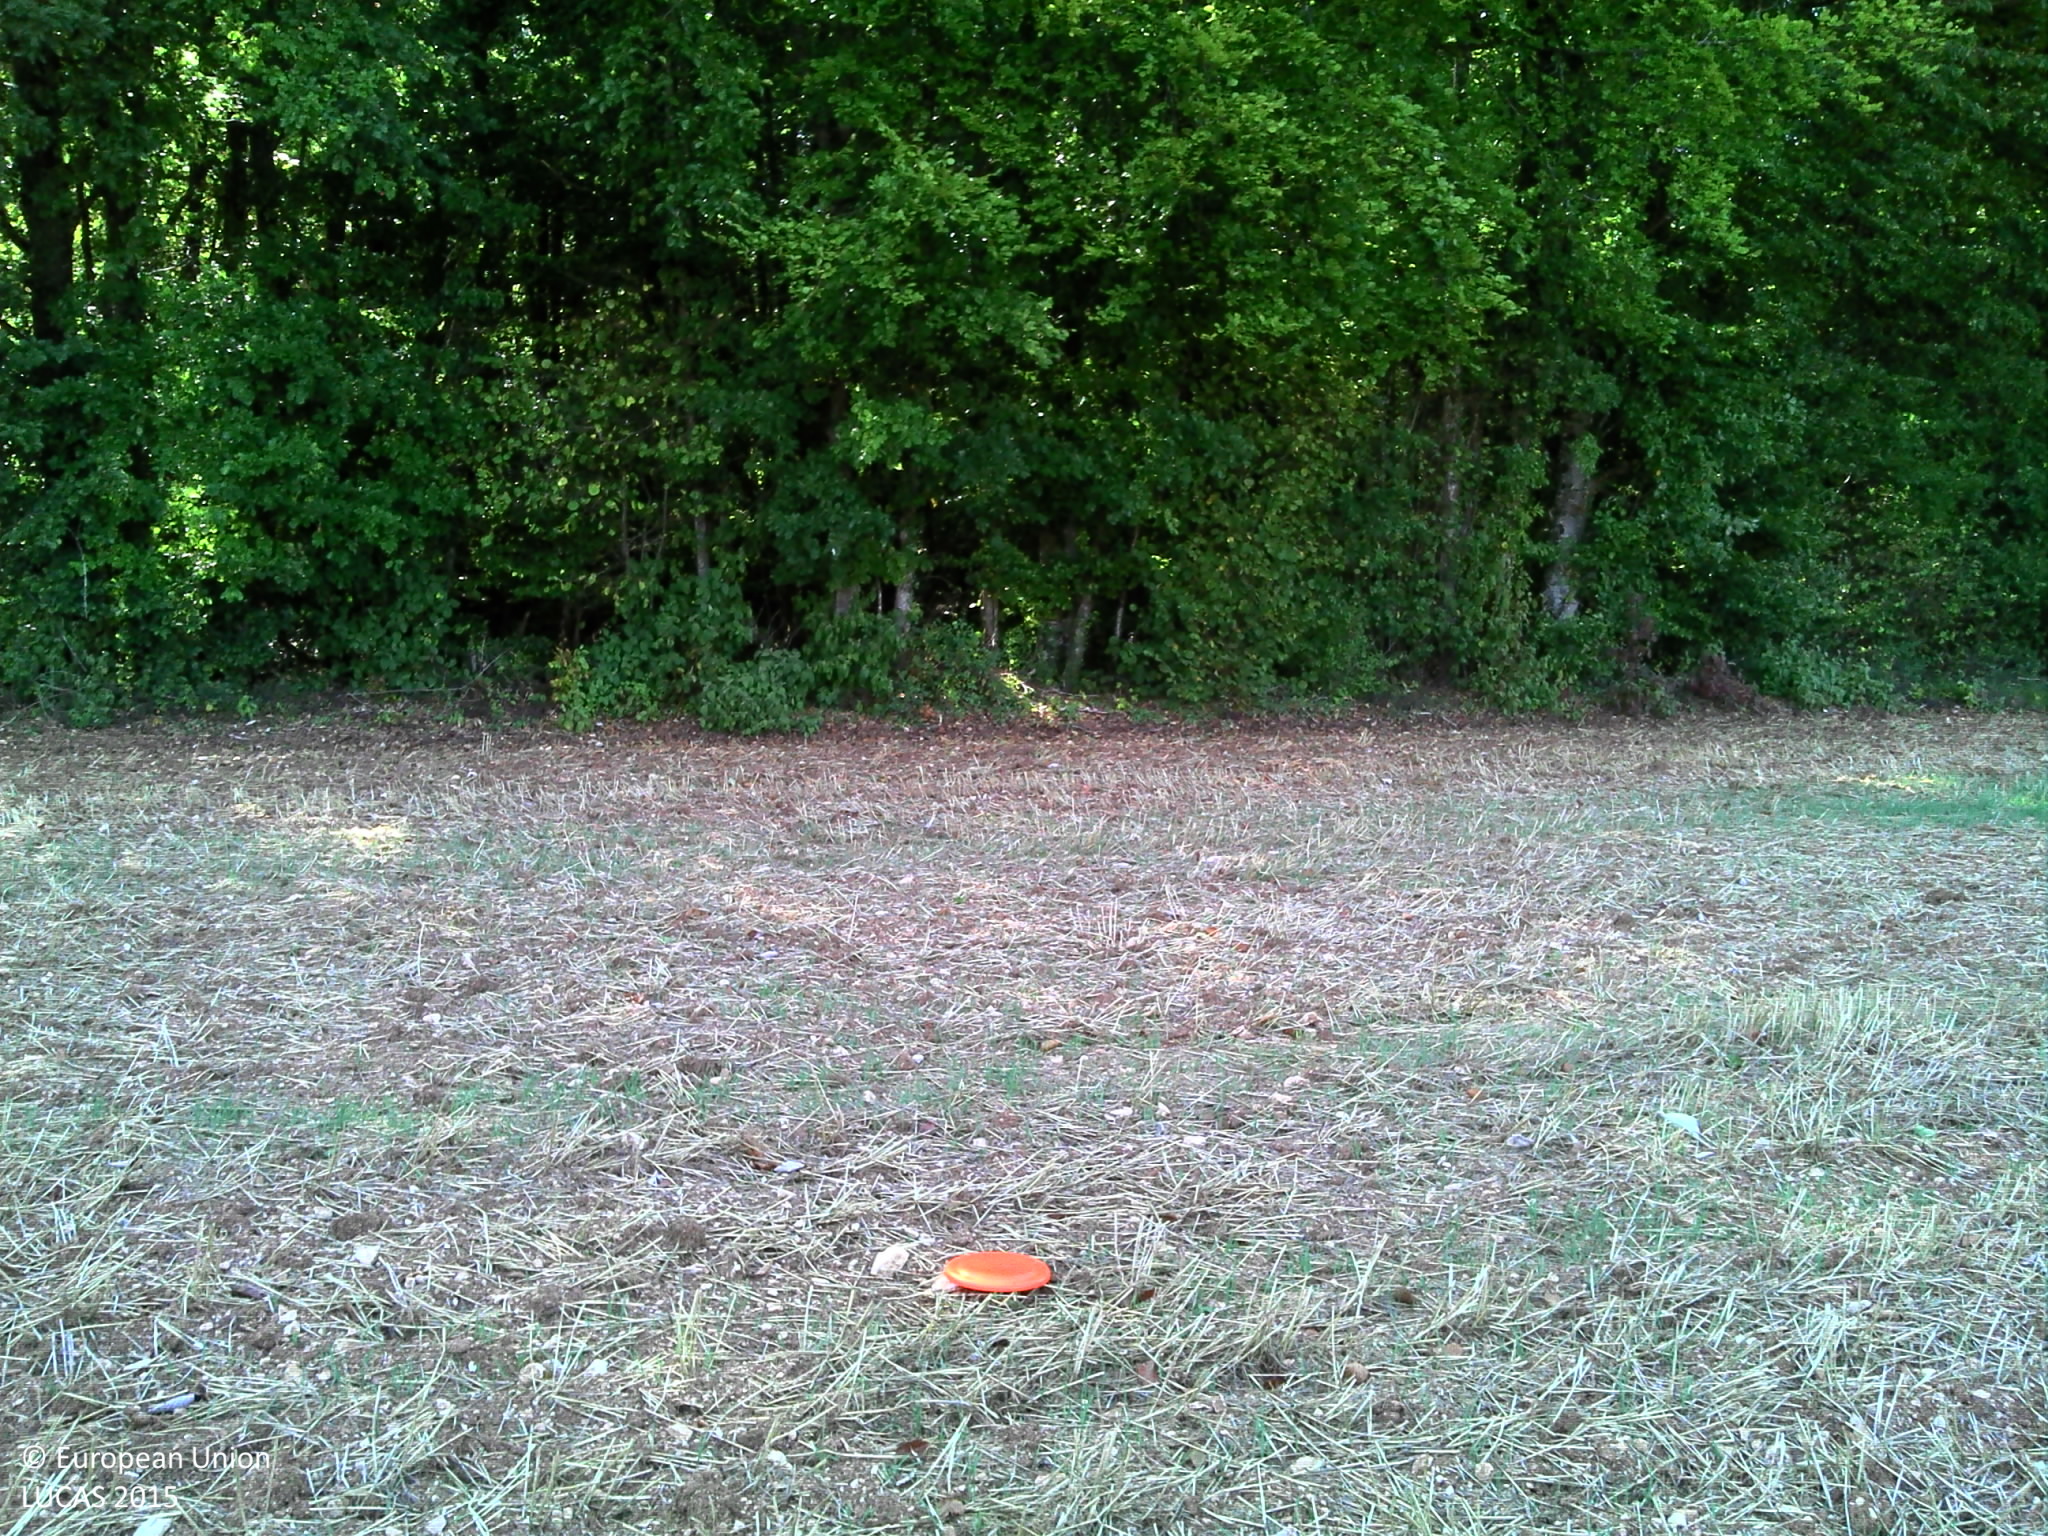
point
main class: Cropland
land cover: Common wheat
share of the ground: > 75 %
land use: Agriculture (excluding fallow land and kitchen gardens)
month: August
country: FR
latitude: 47.7816
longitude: 4.9144
